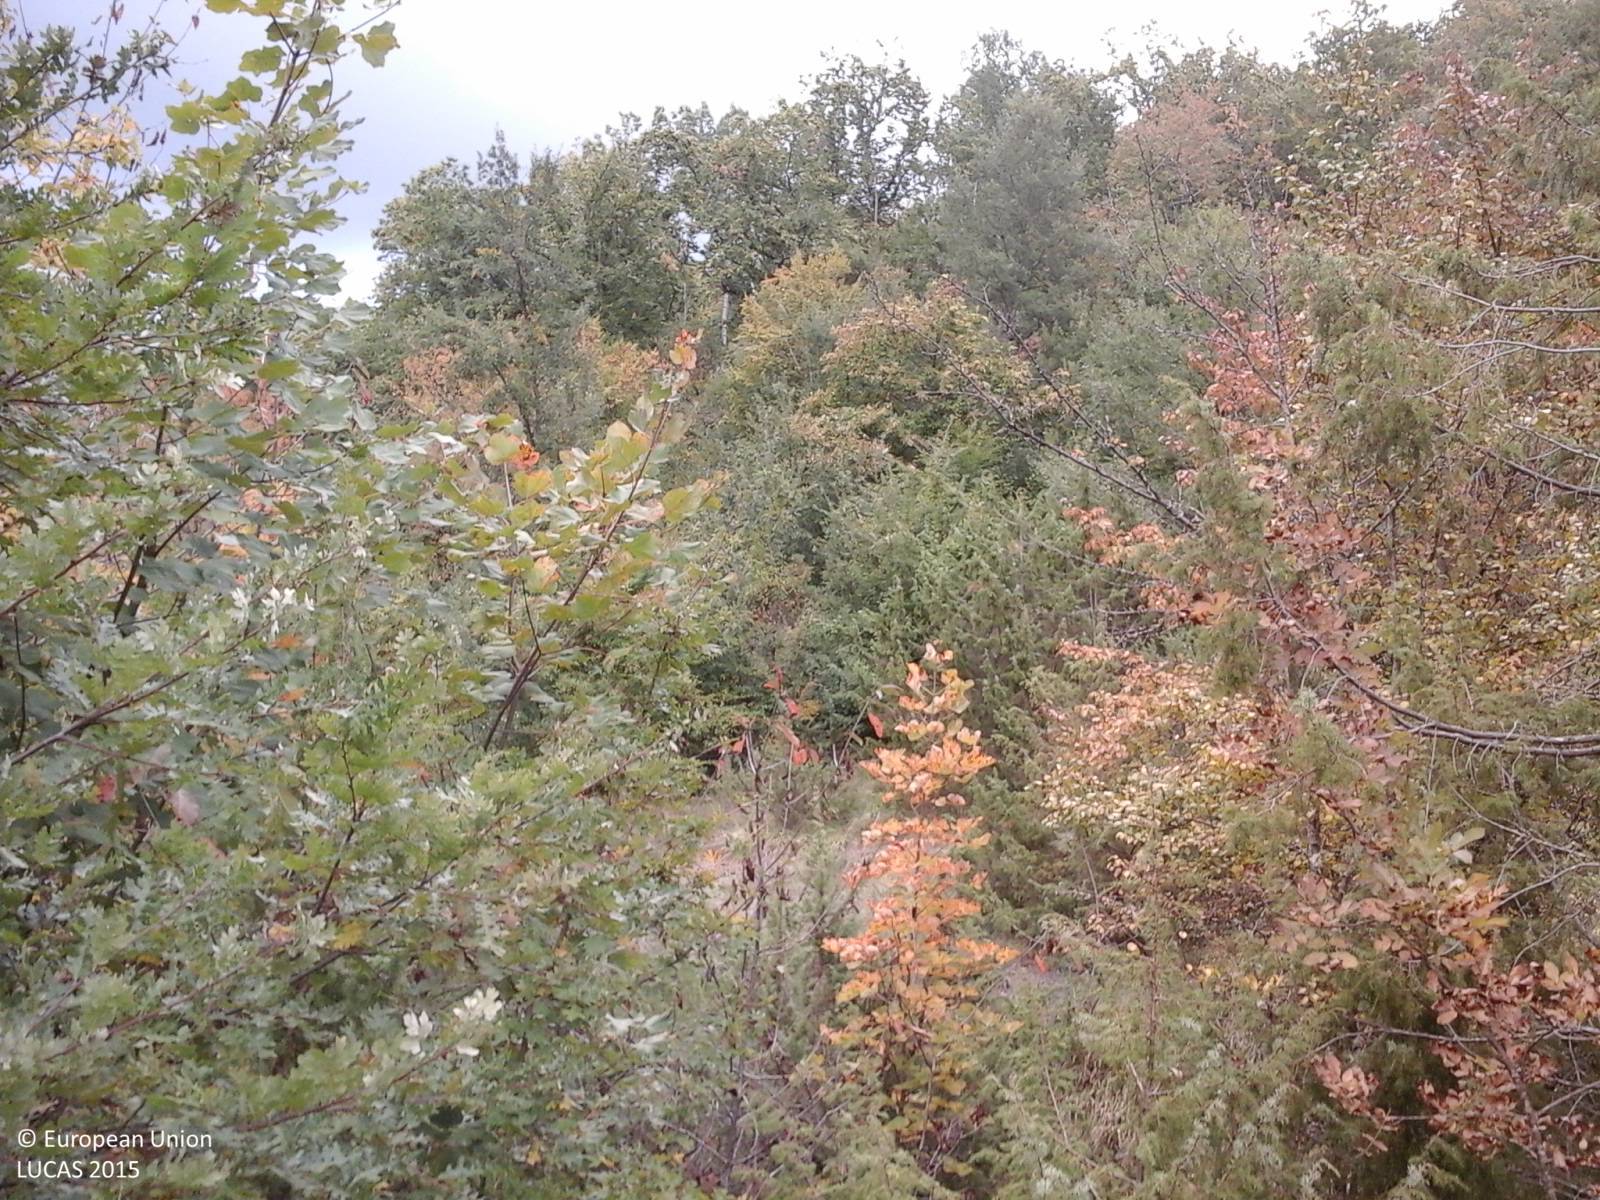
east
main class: Shrubland
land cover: Shrubland with sparse tree cover
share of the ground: > 75 %
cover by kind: shrubs 80 %, herbaceous plants 15 %, broadleaved forest trees 5 %
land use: Semi-natural and natural areas not in use
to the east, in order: Shrubland with sparse tree cover; Tracks; Broadleaved woodland
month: October
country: IT
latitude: 42.5502
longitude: 13.1686
